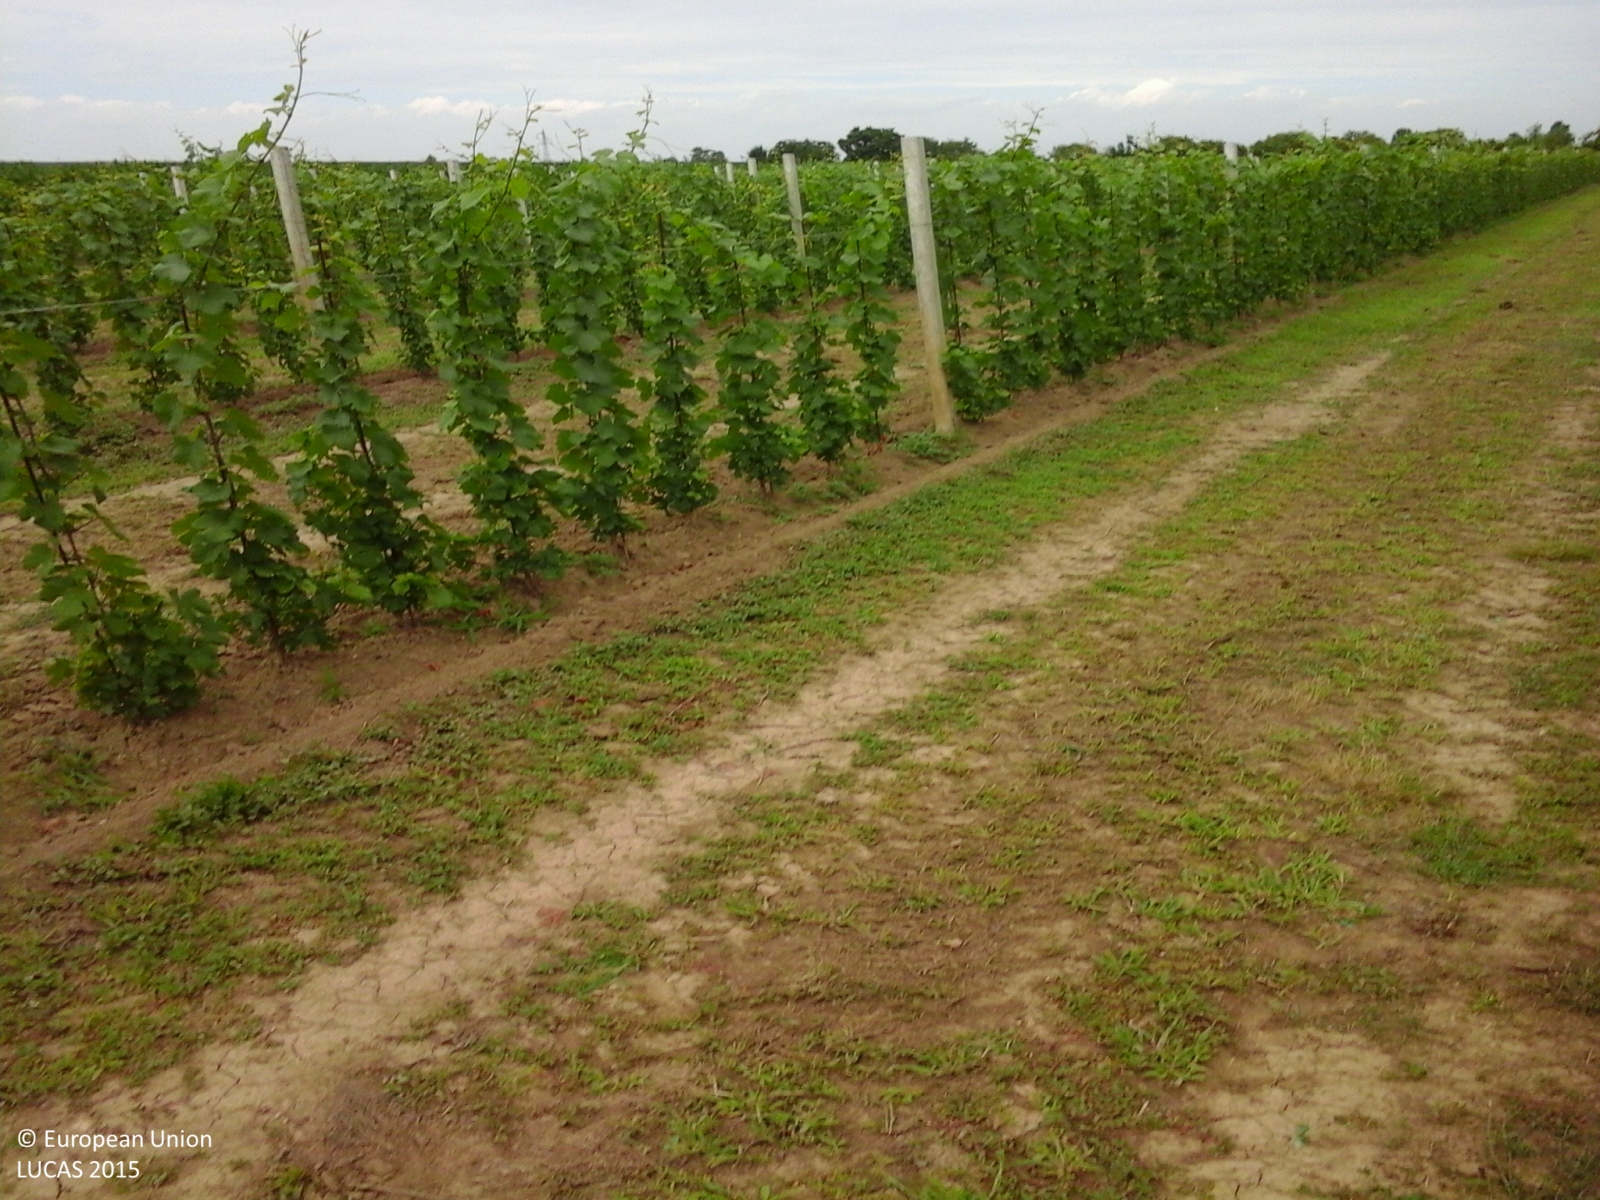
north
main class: Cropland
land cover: Vineyards
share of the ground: 50 - 75 %
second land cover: Grassland without tree/shrub cover
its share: 50 - 75 %
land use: Agriculture (excluding fallow land and kitchen gardens)
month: June
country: IT
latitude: 45.7656
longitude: 12.4011
